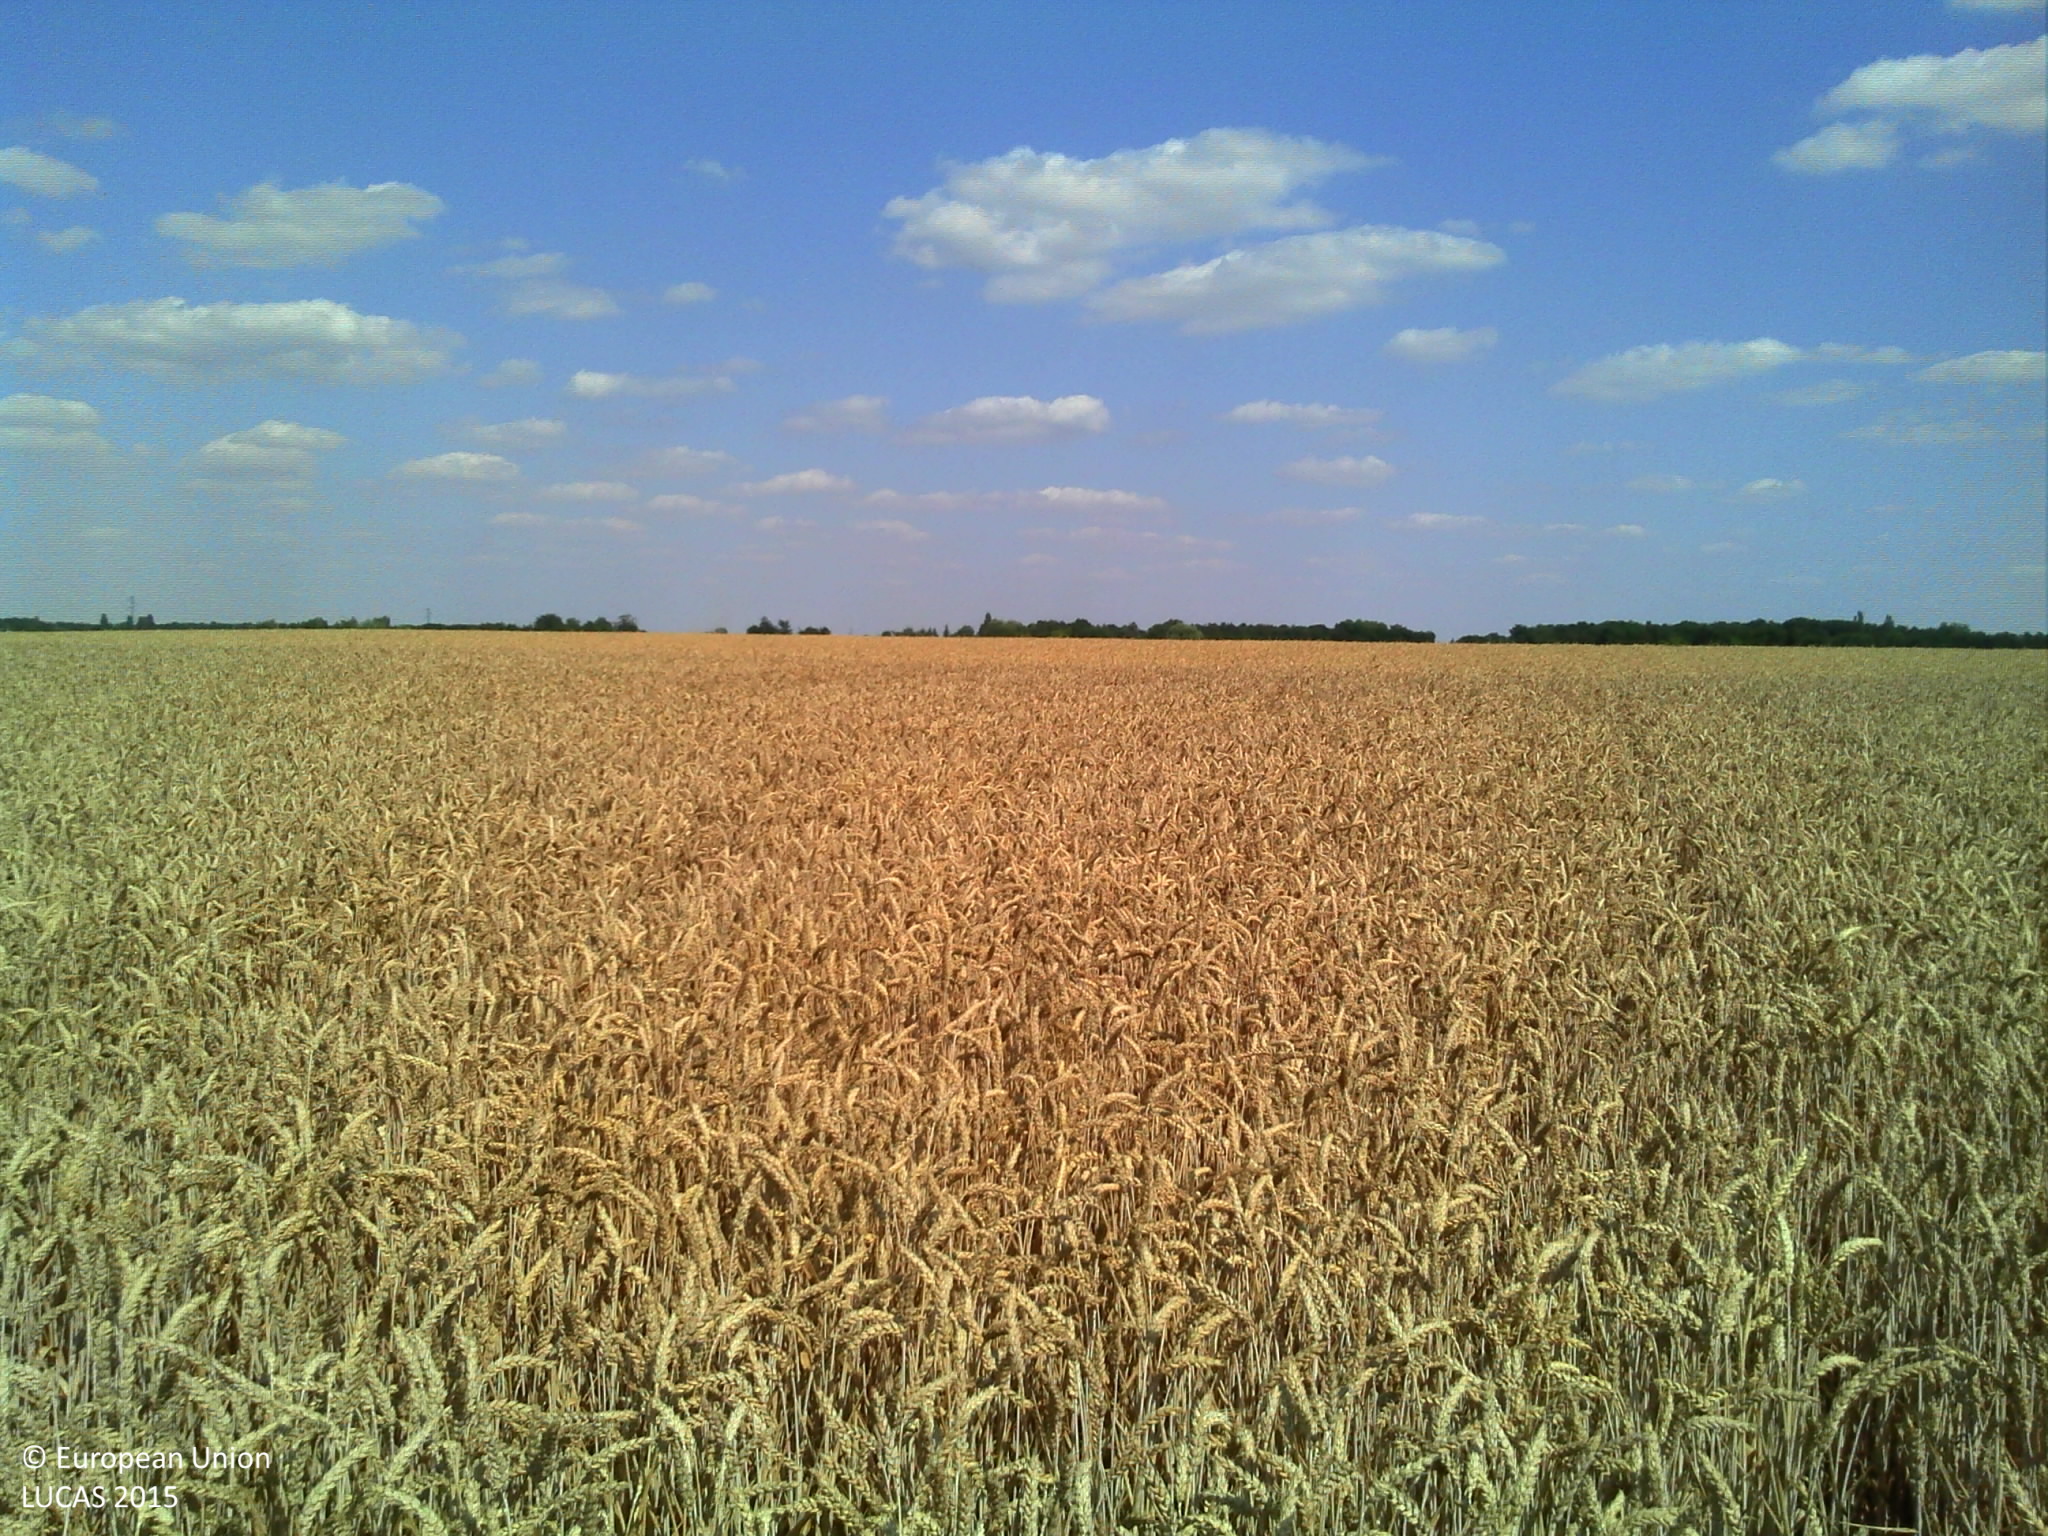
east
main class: Cropland
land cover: Common wheat
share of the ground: > 75 %
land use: Agriculture (excluding fallow land and kitchen gardens)
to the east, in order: Common wheat
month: July
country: FR
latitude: 48.0451
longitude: 2.5727
